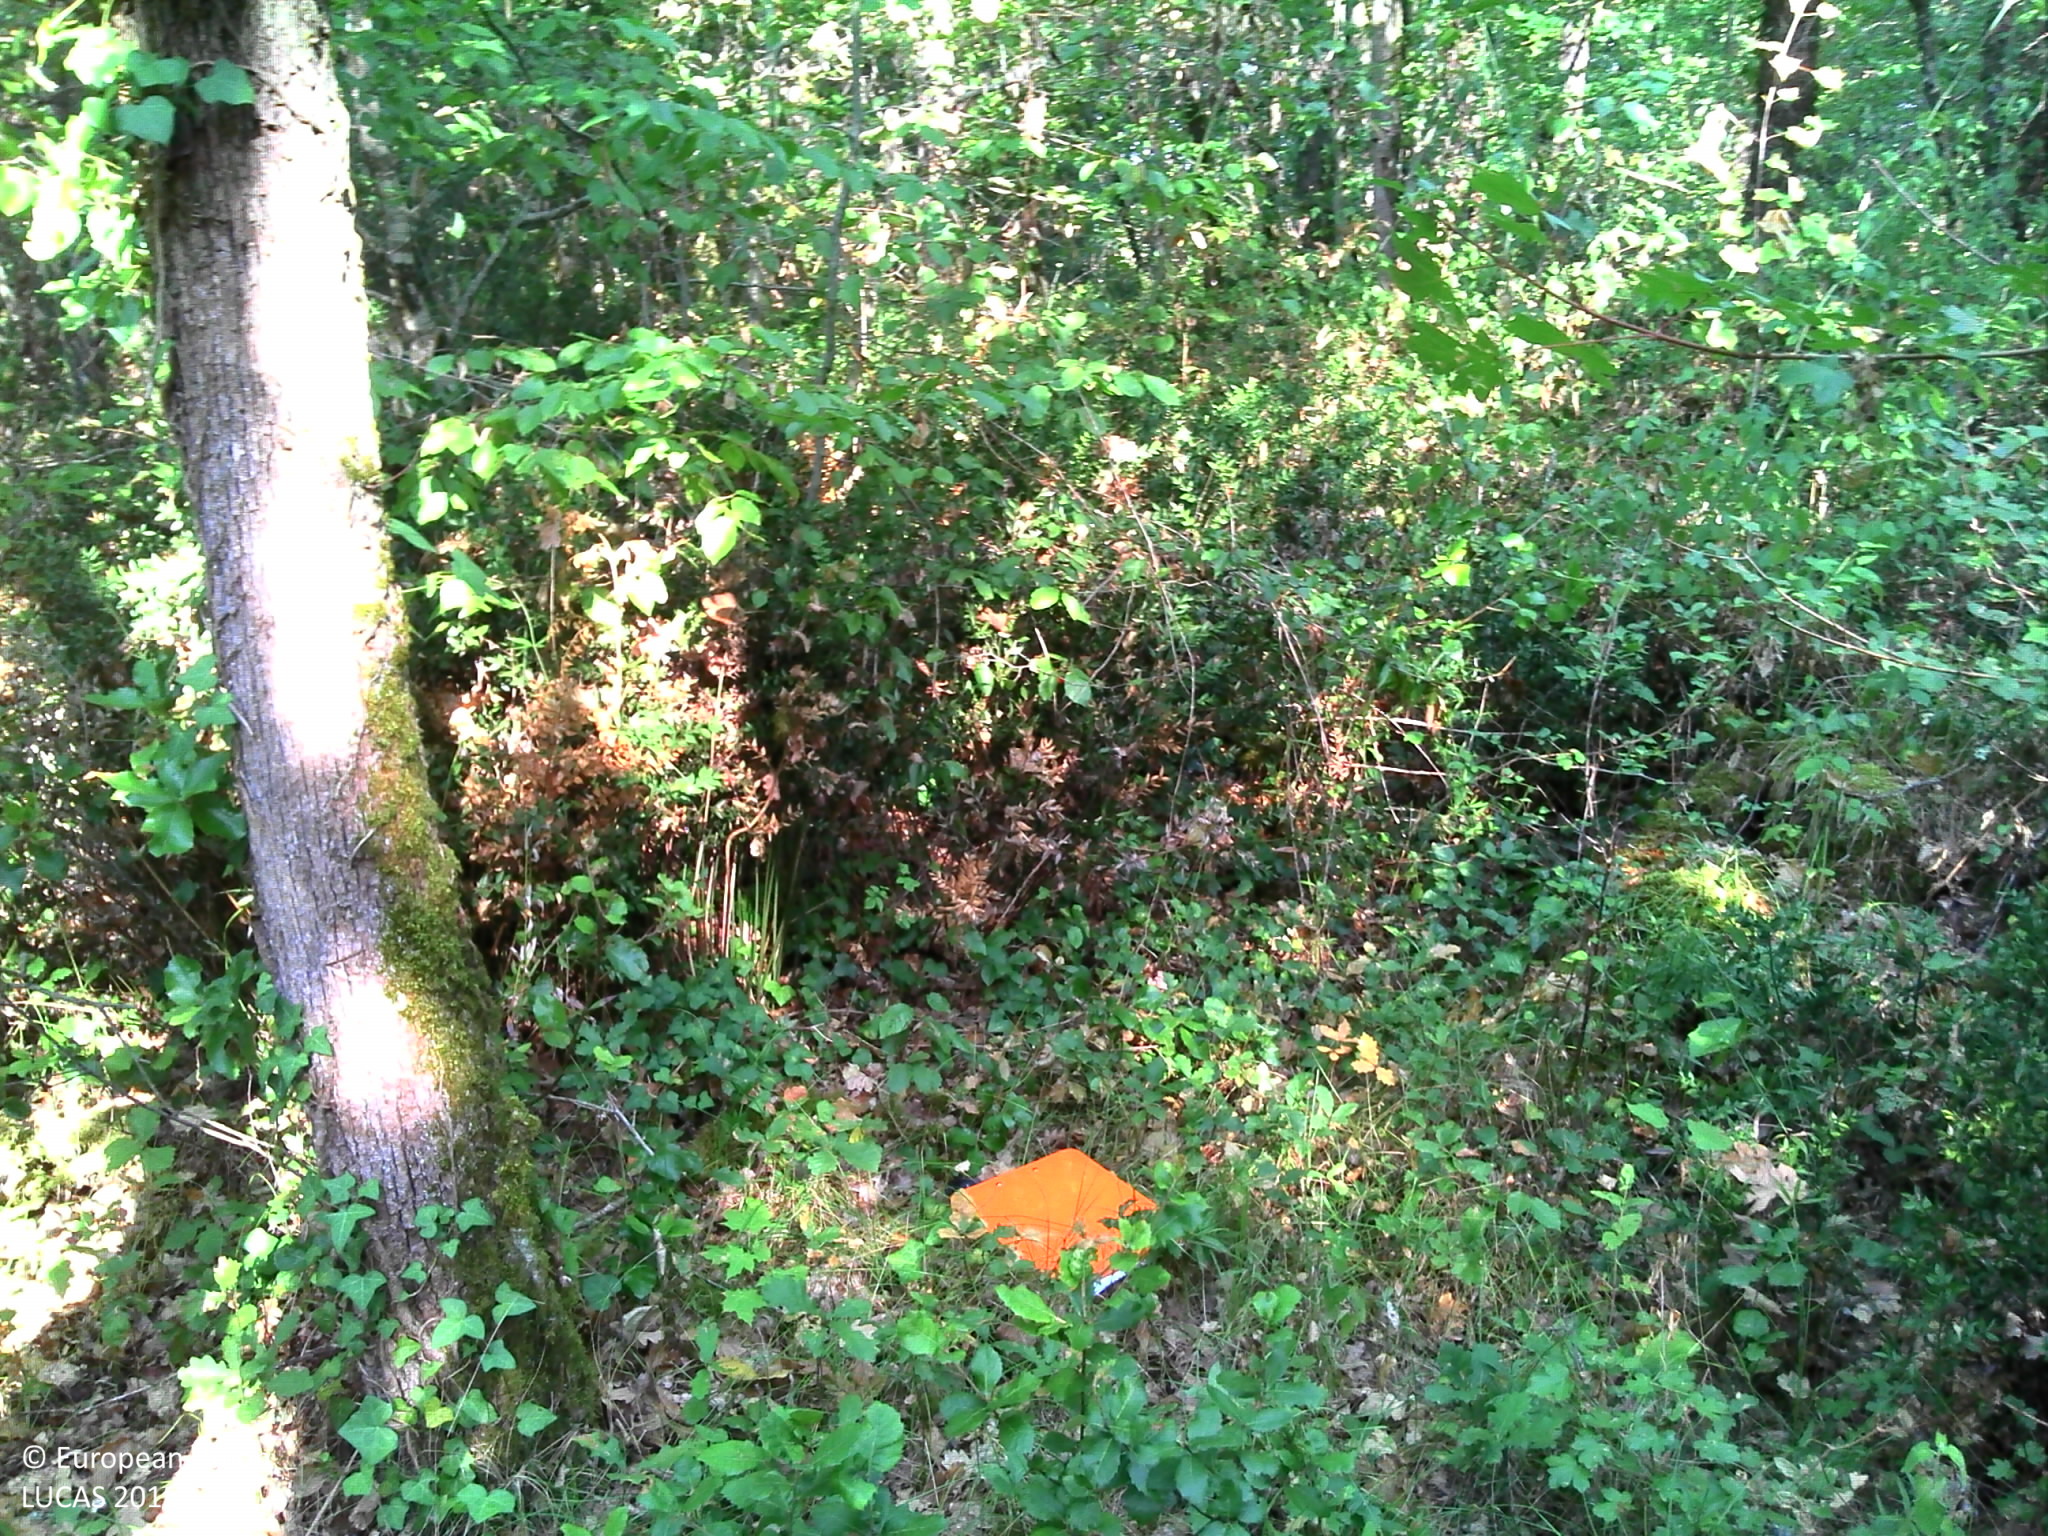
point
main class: Woodland
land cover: Broadleaved woodland
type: acidophilous oak and oak-birch forest
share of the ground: > 75 %
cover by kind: broadleaved forest trees 80 %, herbaceous plants 10 %, lichens and mosses 10 %
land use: Forestry
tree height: > 5 m
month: August
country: FR
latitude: 44.8308
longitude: 1.2296
